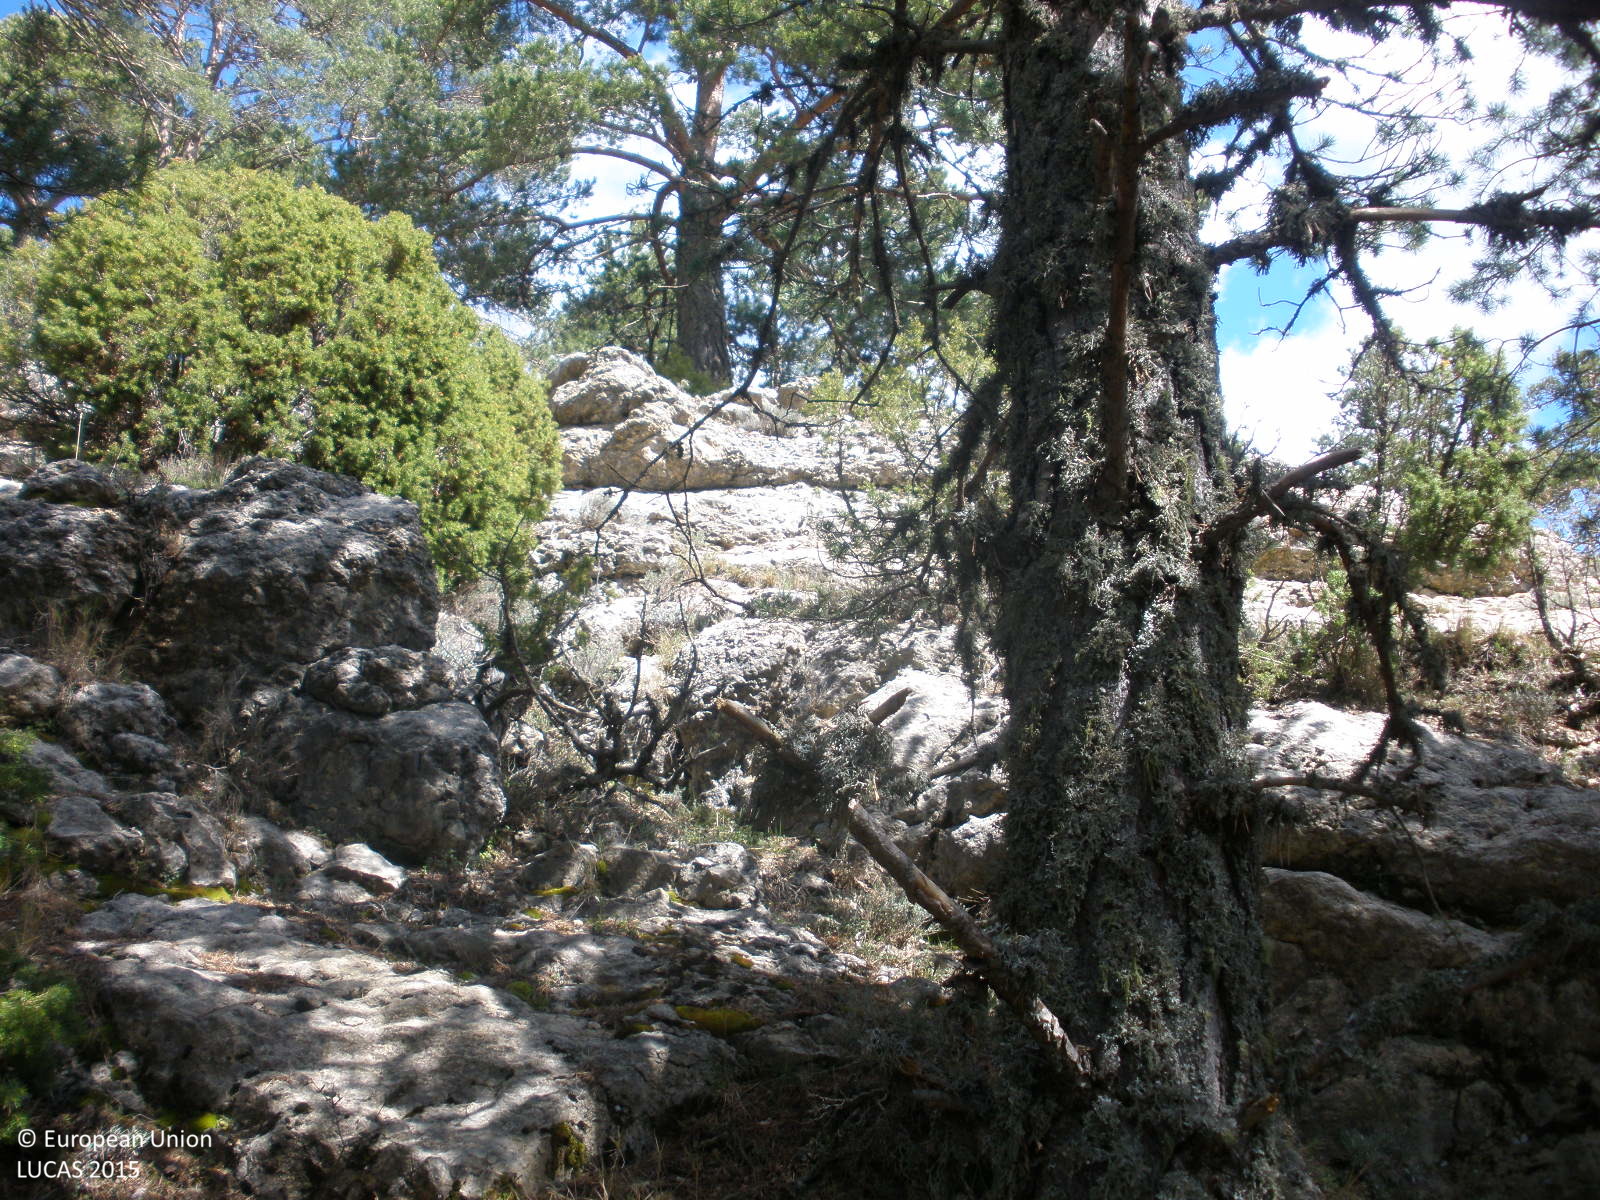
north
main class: Woodland
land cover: Pine dominated coniferous woodland
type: coniferous forest of the mediterranean region
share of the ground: > 75 %
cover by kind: coniferous forest trees 80 %, herbaceous plants 10 %, consolidated bare surface 10 %
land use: Semi-natural and natural areas not in use
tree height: > 5 m
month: April
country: ES
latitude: 40.3667
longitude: -0.7605
